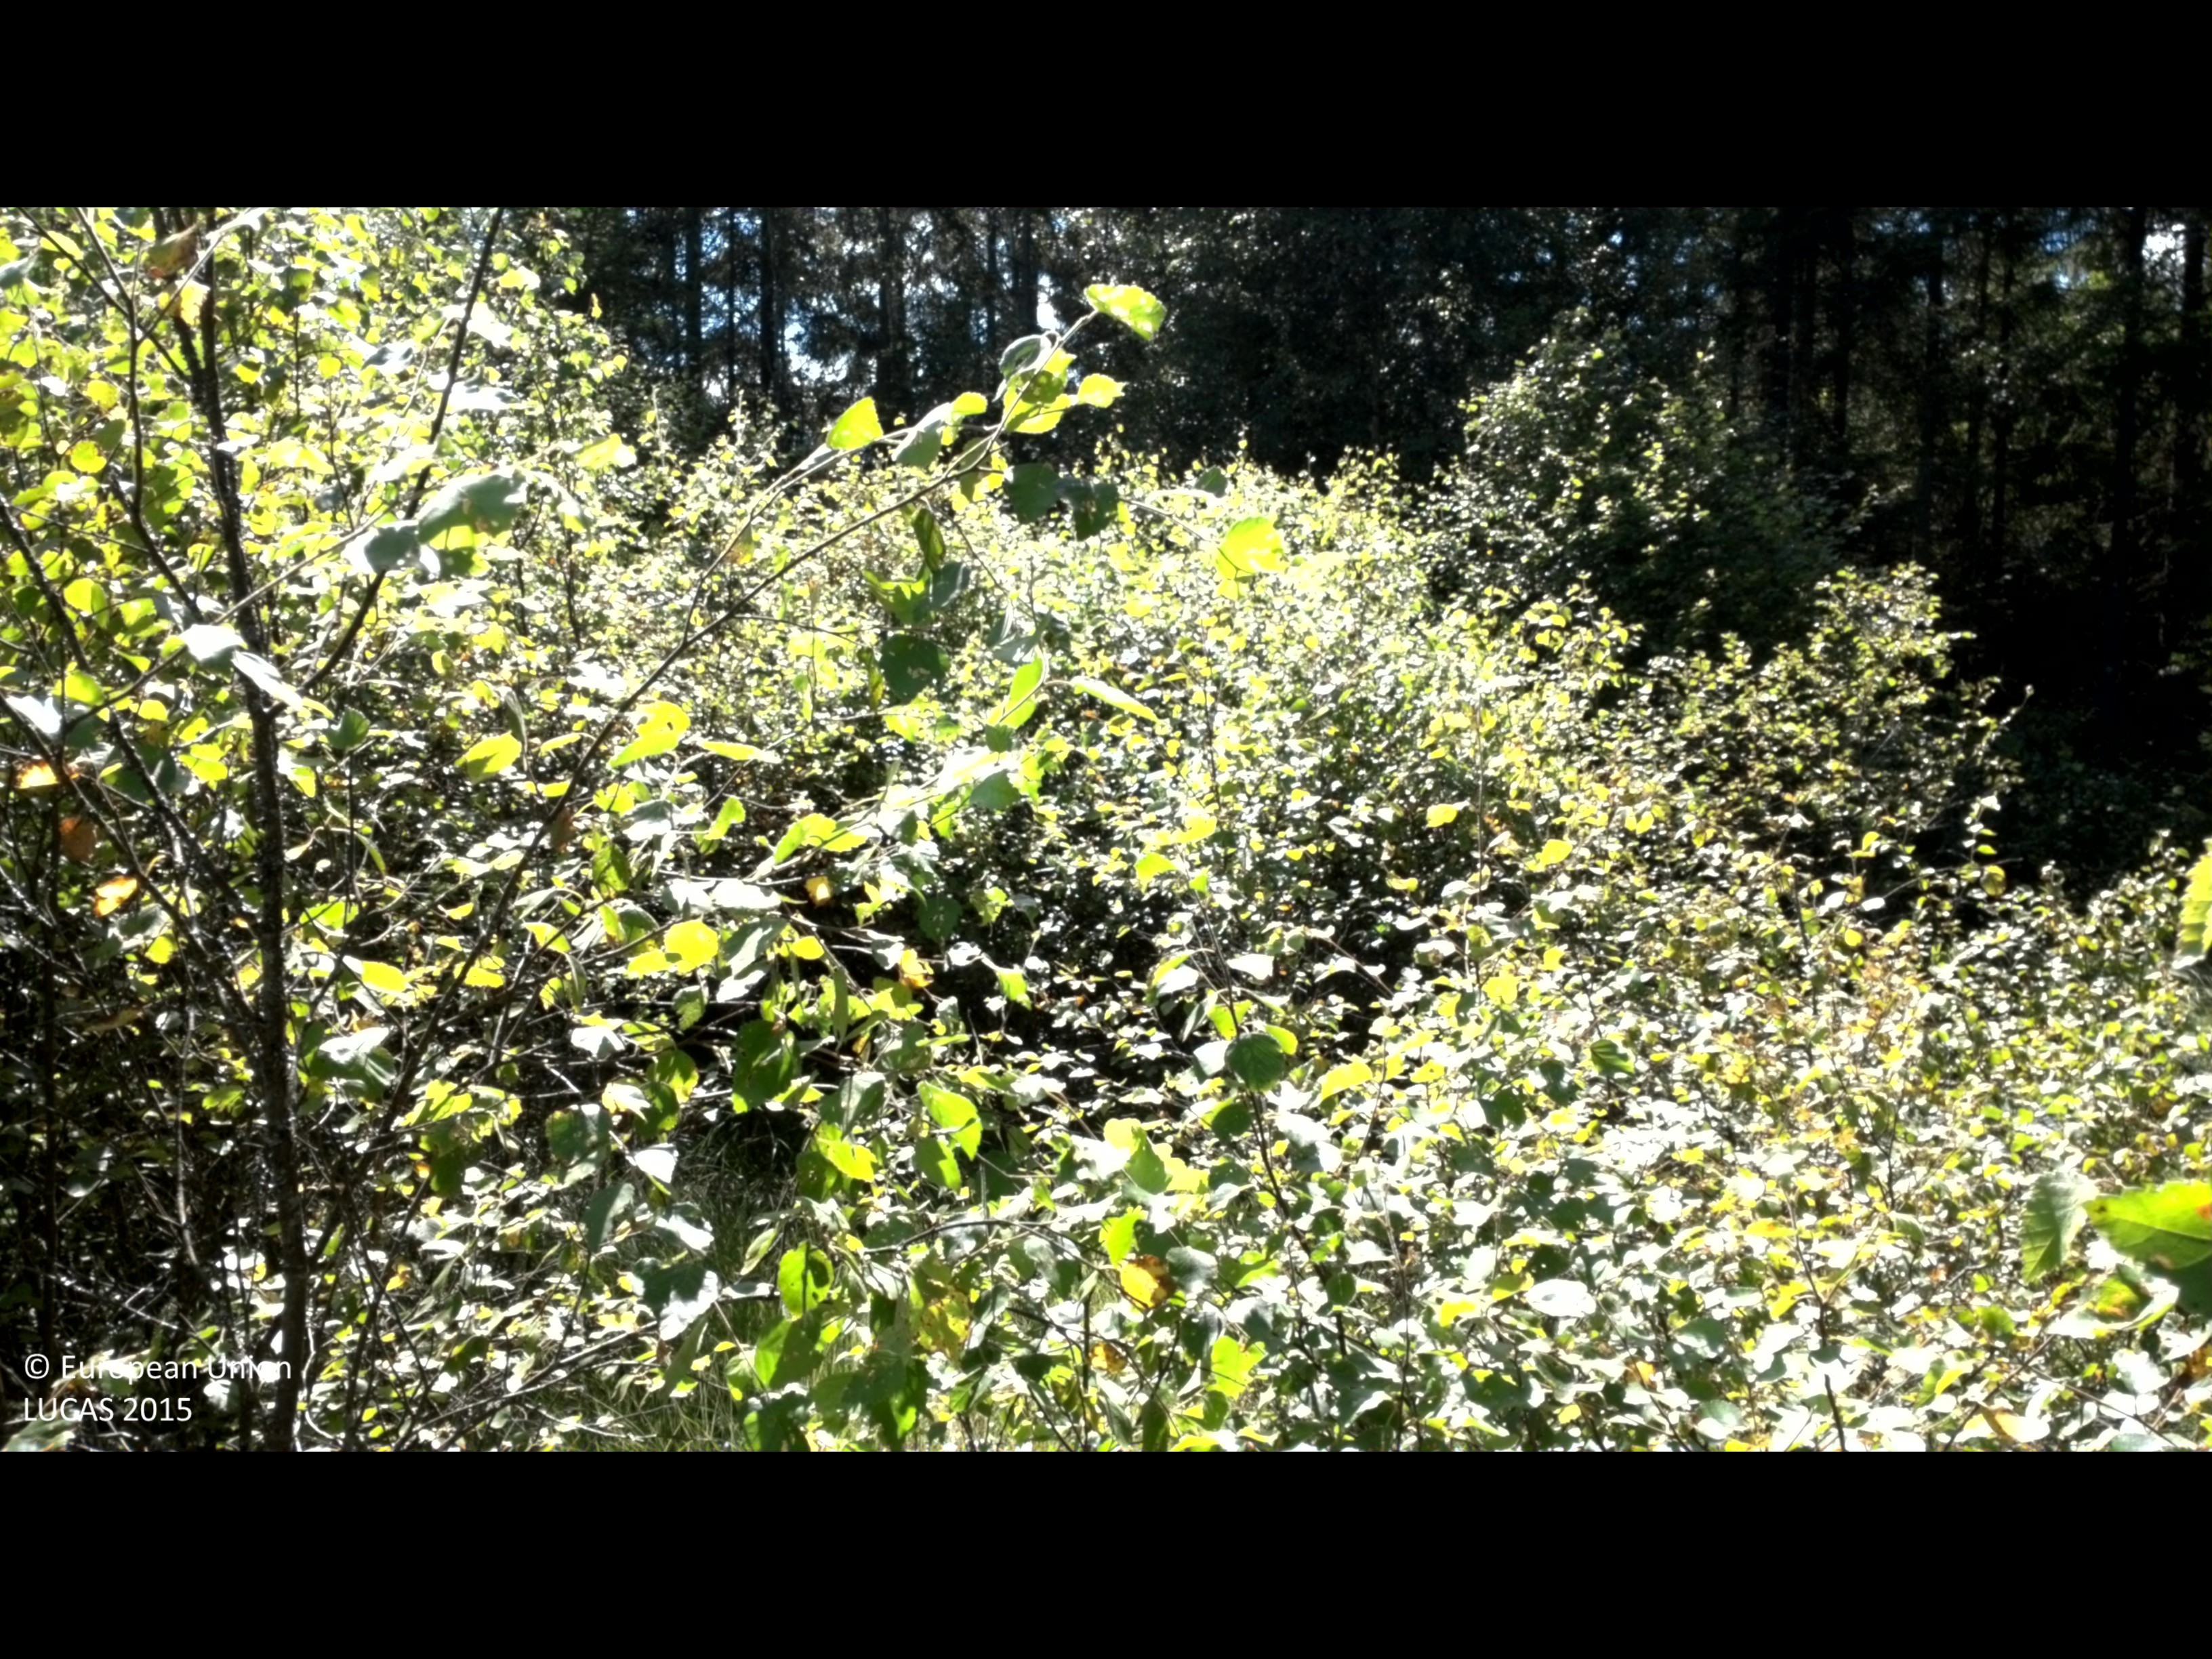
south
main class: Woodland
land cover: Spruce dominated mixed woodland
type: boreal forest
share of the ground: > 75 %
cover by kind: broadleaved forest trees 55 %, coniferous forest trees 30 %, shrubs 10 %, herbaceous plants 5 %
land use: Forestry
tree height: > 5 m
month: August
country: SE
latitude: 56.7281
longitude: 14.2953
